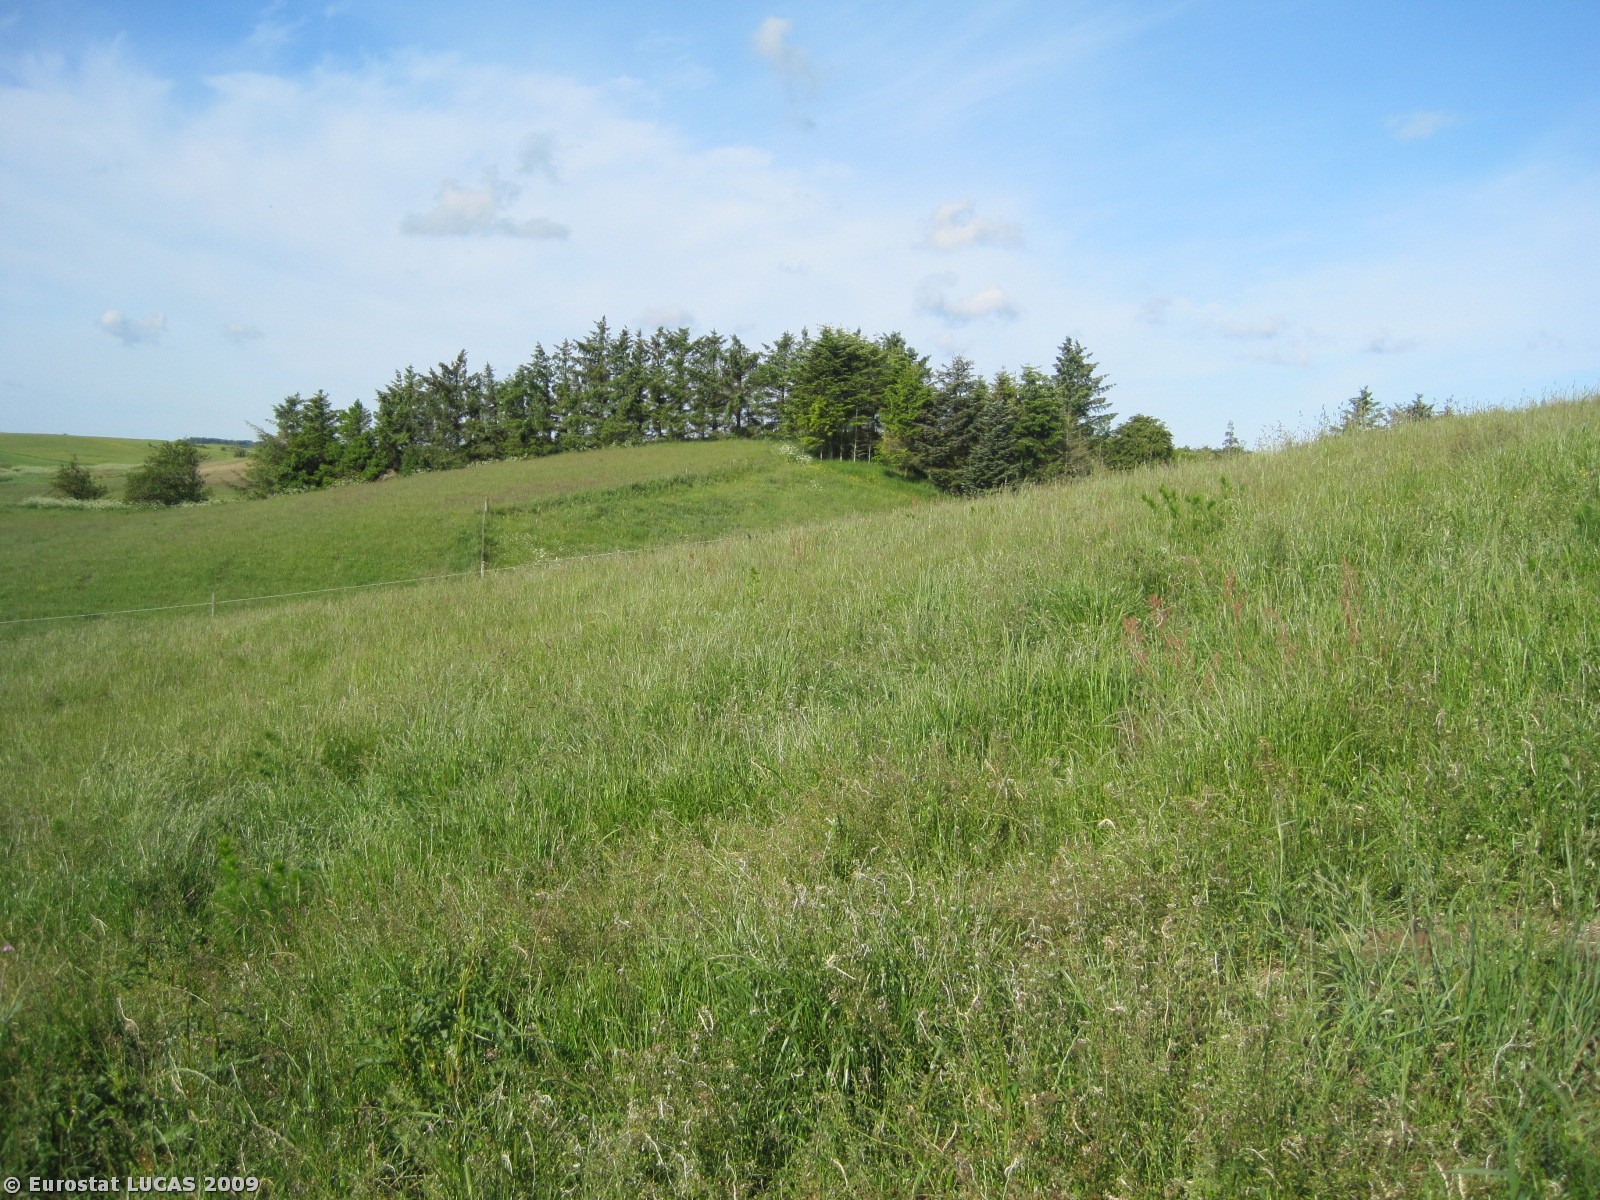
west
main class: Grassland
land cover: Grassland without tree/shrub cover
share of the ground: > 75 %
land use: Agriculture (excluding fallow land and kitchen gardens)
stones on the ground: < 10 %
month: June
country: DK
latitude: 57.4461
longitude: 9.8836
